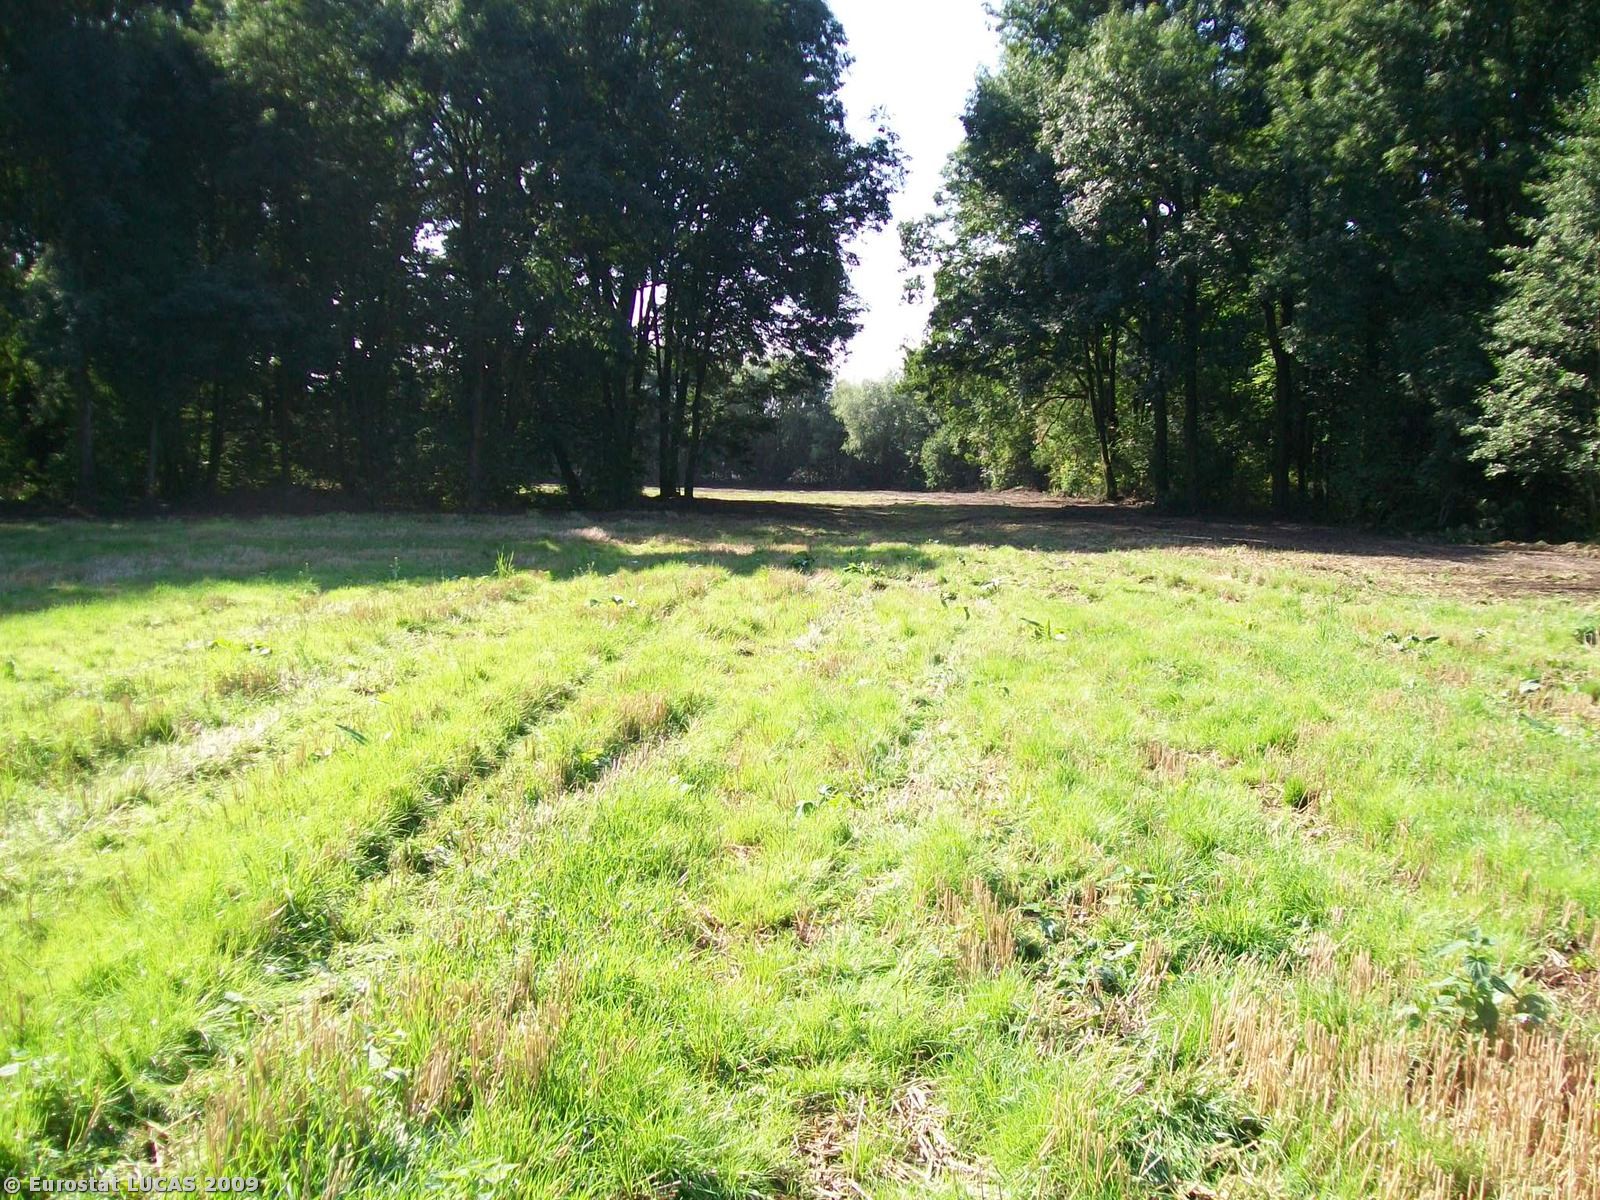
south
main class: Cropland
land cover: Common wheat
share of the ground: < 10 %
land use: Agriculture (excluding fallow land and kitchen gardens)
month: September
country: PL
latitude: 50.5151
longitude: 17.2176
